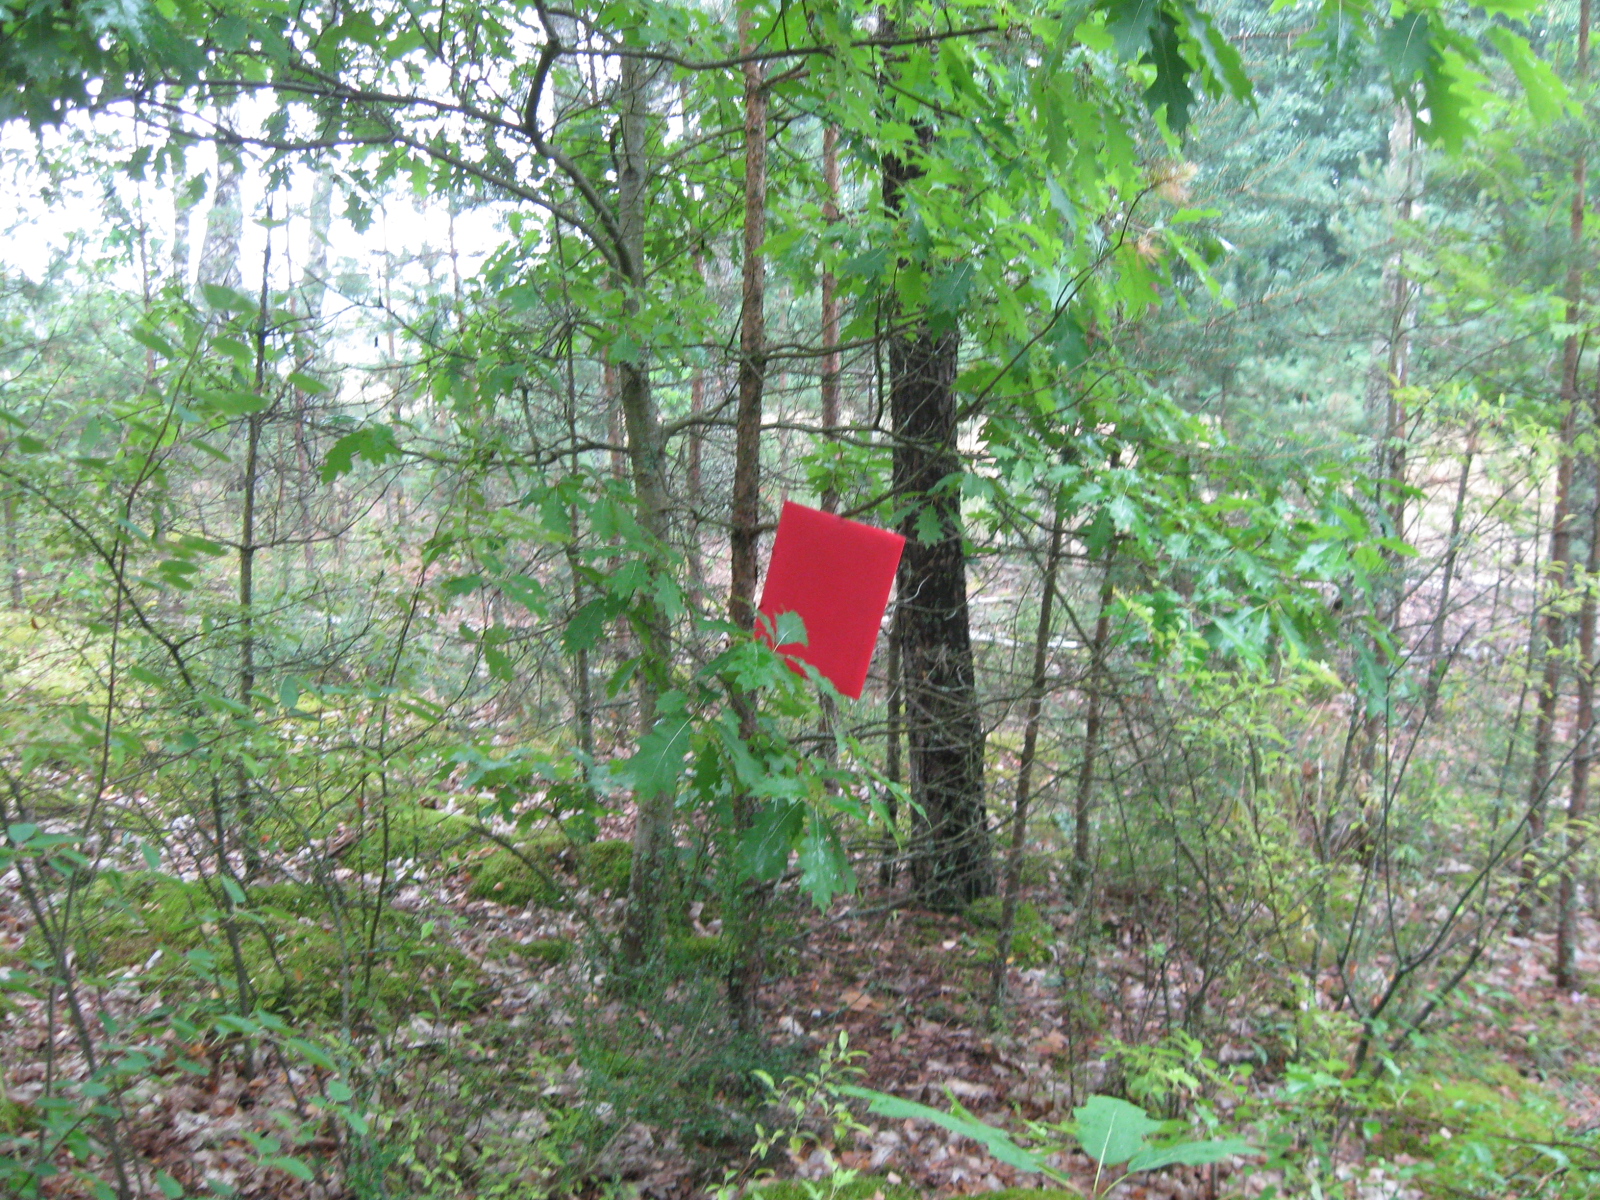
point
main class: Woodland
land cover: Pine dominated mixed woodland
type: hemiboreal forest and nemoral coniferous forest and mixed broadleaved-coniferous forest
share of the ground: > 75 %
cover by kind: coniferous forest trees 50 %, broadleaved forest trees 30 %, herbaceous plants 10 %, shrubs 5 %, lichens and mosses 5 %
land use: Forestry
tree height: > 5 m
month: July
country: LT
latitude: 53.9934
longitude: 23.6459
